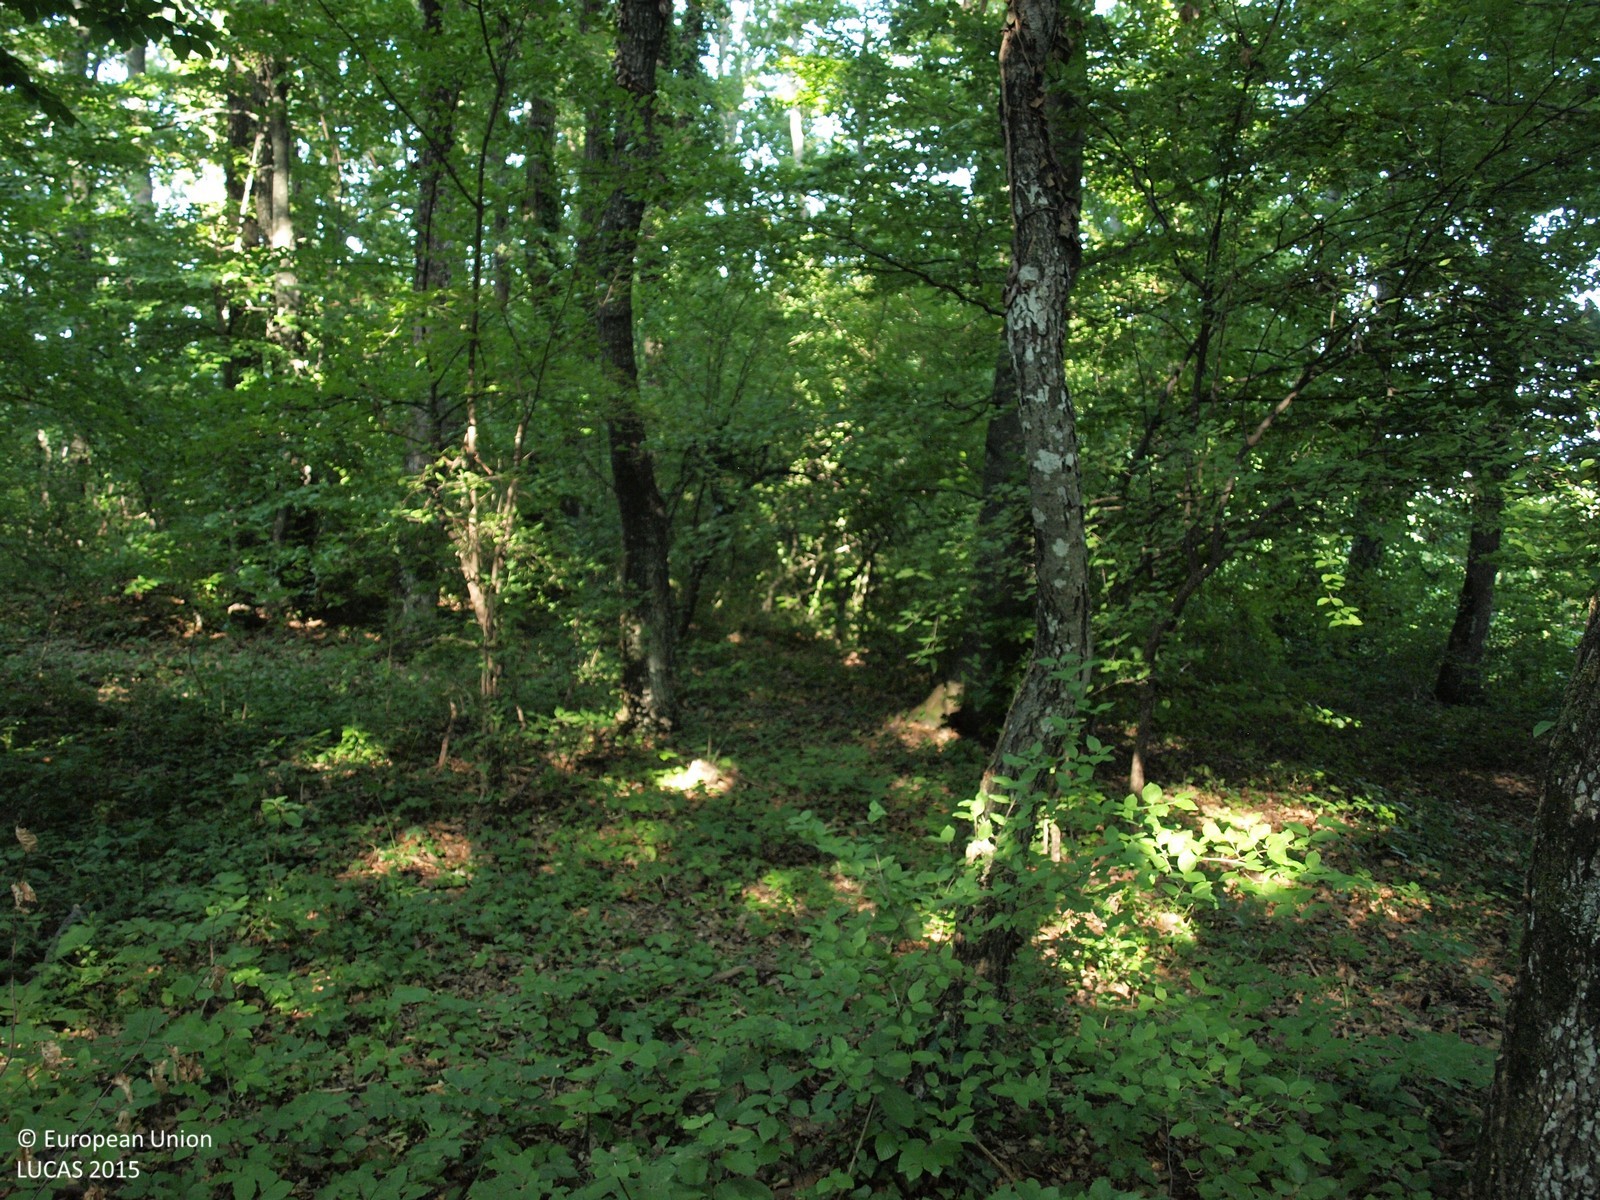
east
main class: Woodland
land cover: Broadleaved woodland
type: mesophytic deciduous forest
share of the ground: > 75 %
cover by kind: broadleaved forest trees 100 %
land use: Forestry
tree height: > 5 m
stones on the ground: < 10 %
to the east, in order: Broadleaved woodland; Paved roads, cycling and walking lanes; Electric lines; Abandoned hedges; Nuts trees; Broadleaved woodland; Electric lines; Paved roads, cycling and walking lanes; Abandoned hedges; Nuts trees; Abandoned hedges; Shrubland with sparse tree cover; Broadleaved woodland
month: July
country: HR
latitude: 46.1650
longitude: 15.9952
